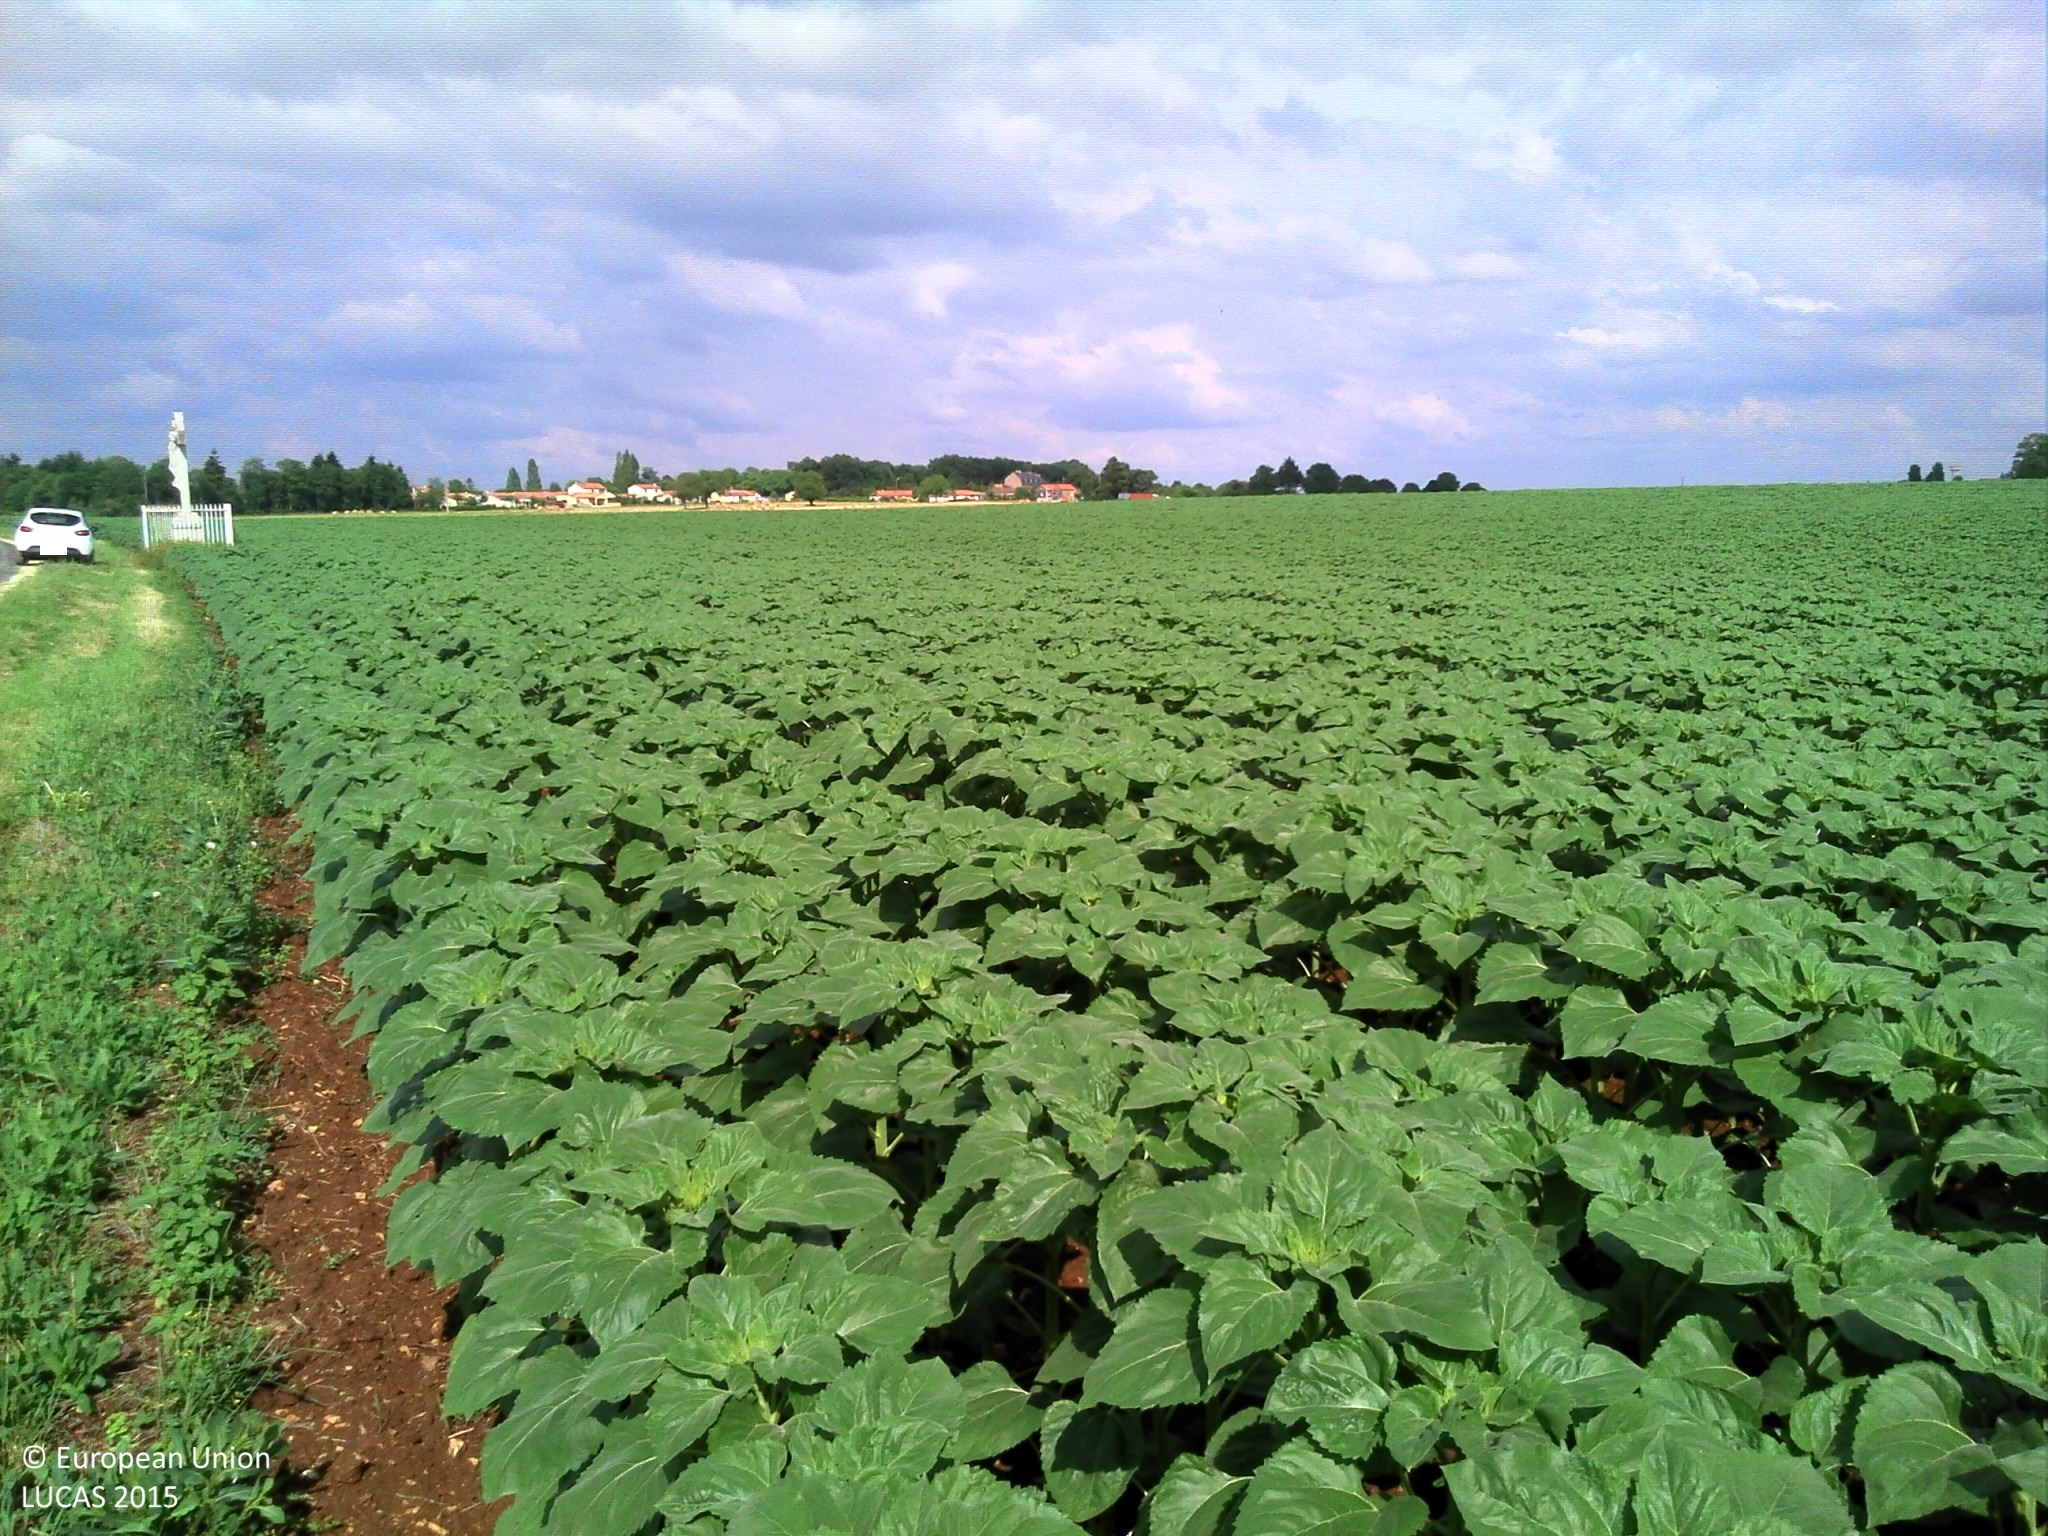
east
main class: Cropland
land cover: Sunflower
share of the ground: > 75 %
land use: Agriculture (excluding fallow land and kitchen gardens)
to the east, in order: Sunflower
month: June
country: FR
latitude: 46.6991
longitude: 0.2100
